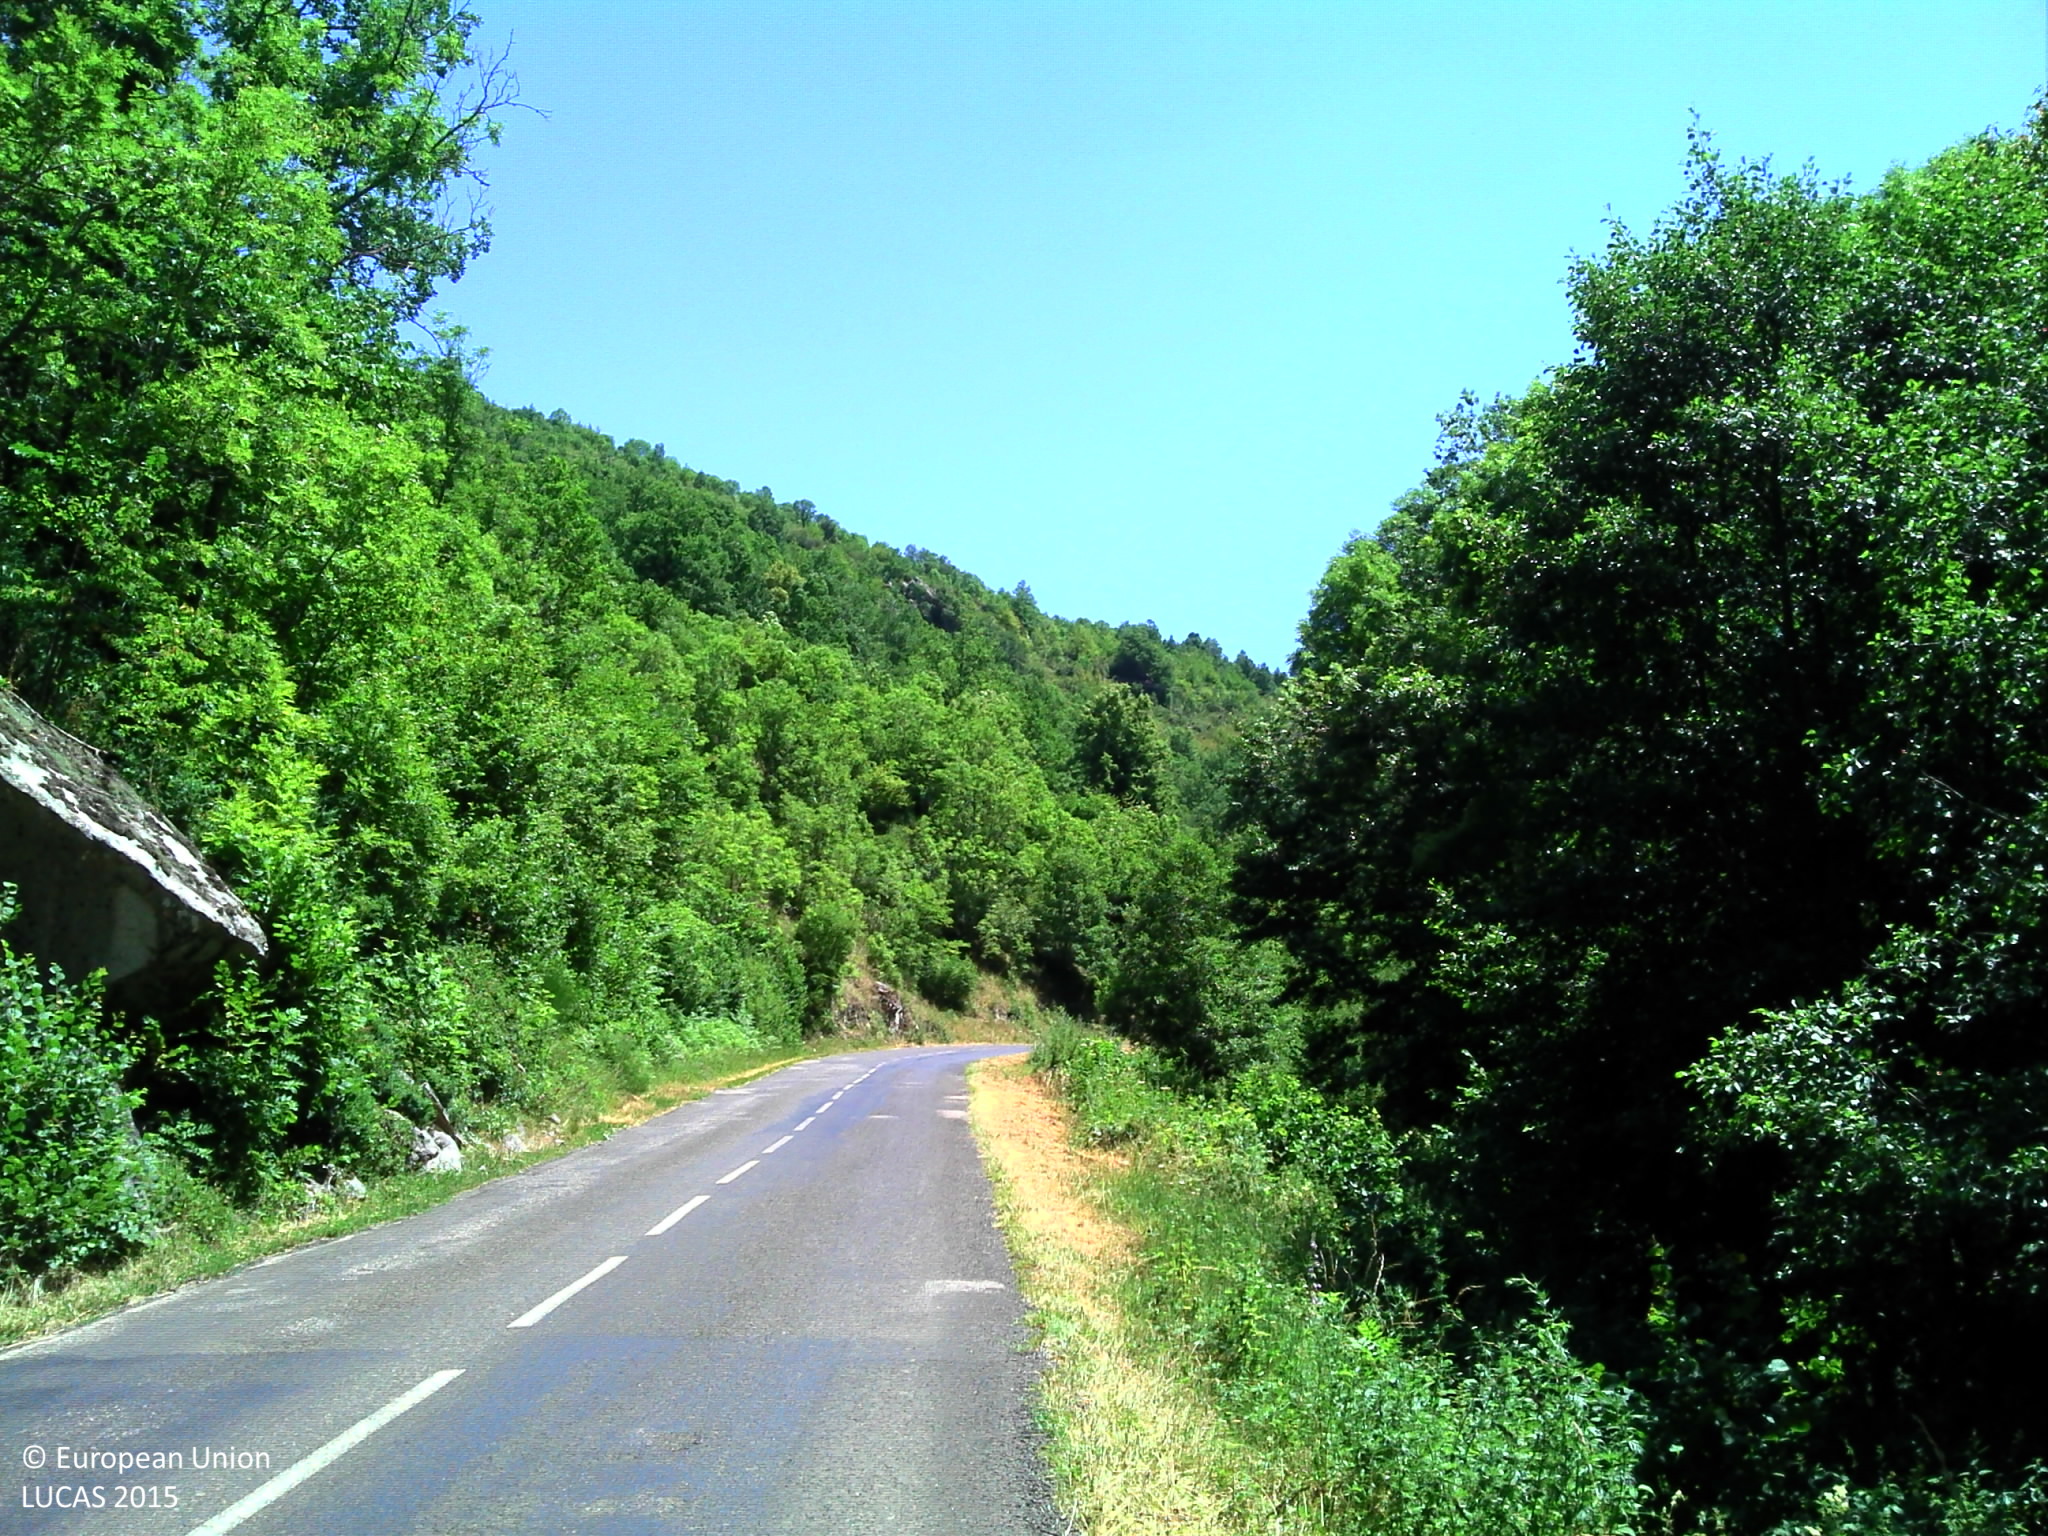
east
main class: Woodland
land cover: Broadleaved woodland
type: mesophytic deciduous forest
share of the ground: > 75 %
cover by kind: broadleaved forest trees 90 %, herbaceous plants 10 %
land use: Semi-natural and natural areas not in use
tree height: > 5 m
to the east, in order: Broadleaved woodland
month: July
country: FR
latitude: 42.7266
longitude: 2.1083
